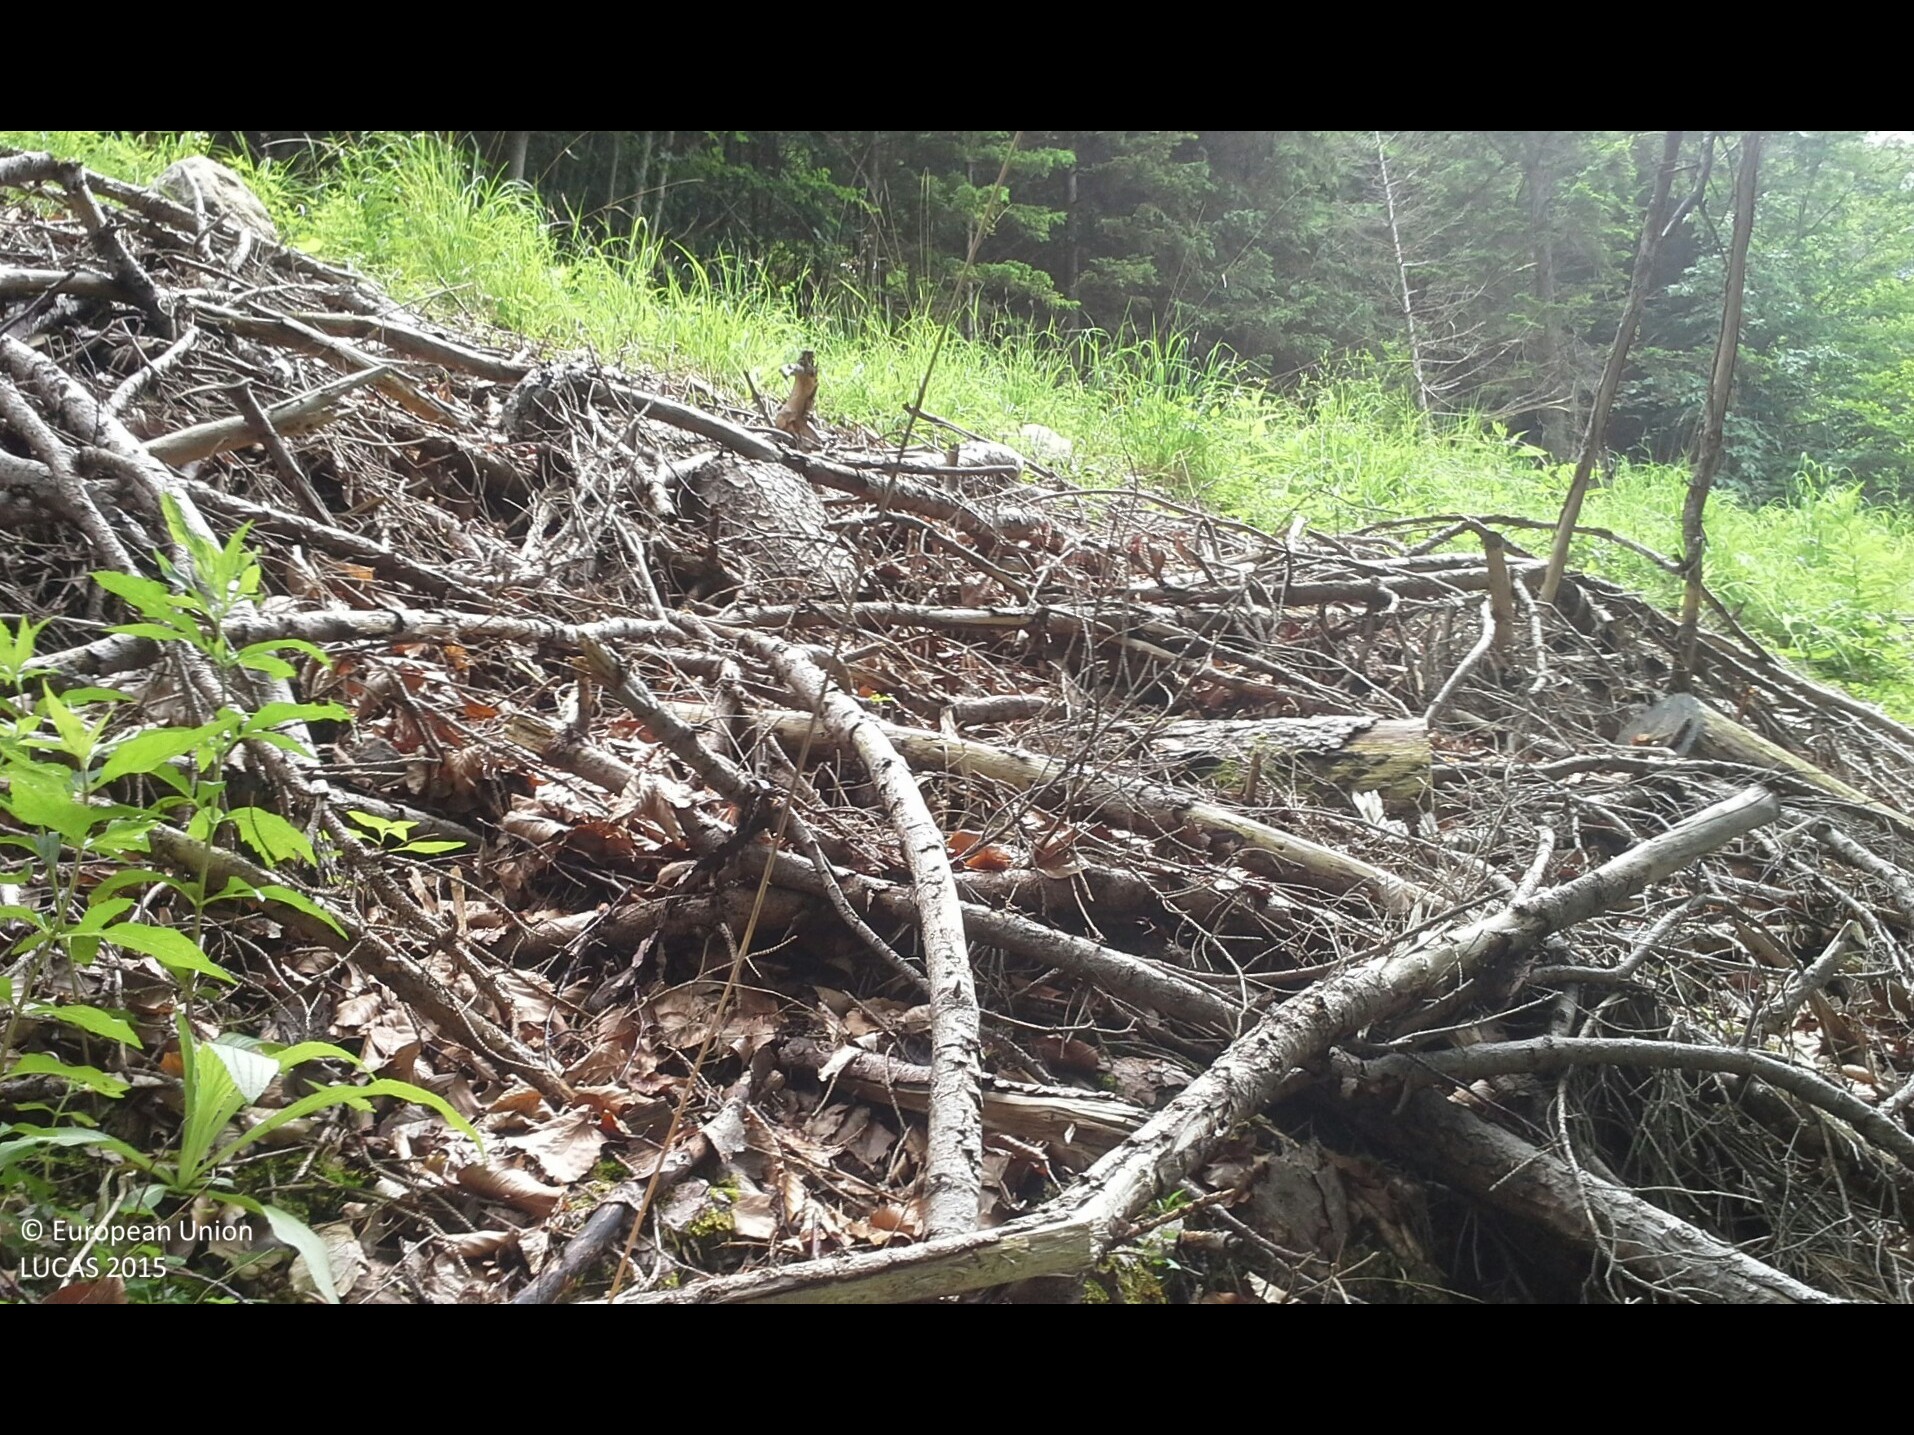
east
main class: Woodland
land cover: Spruce dominated mixed woodland
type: beech forest
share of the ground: > 75 %
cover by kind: broadleaved forest trees 60 %, coniferous forest trees 25 %, herbaceous plants 10 %, unconsolidated bare surface 5 %
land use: Forestry
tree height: > 5 m
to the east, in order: Spruce dominated mixed woodland; Grass margins; Tracks; Other mixed woodland; Spruce dominated mixed woodland; Rocks and stones; Other bare soil
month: June
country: AT
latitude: 47.7626
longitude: 13.7746
